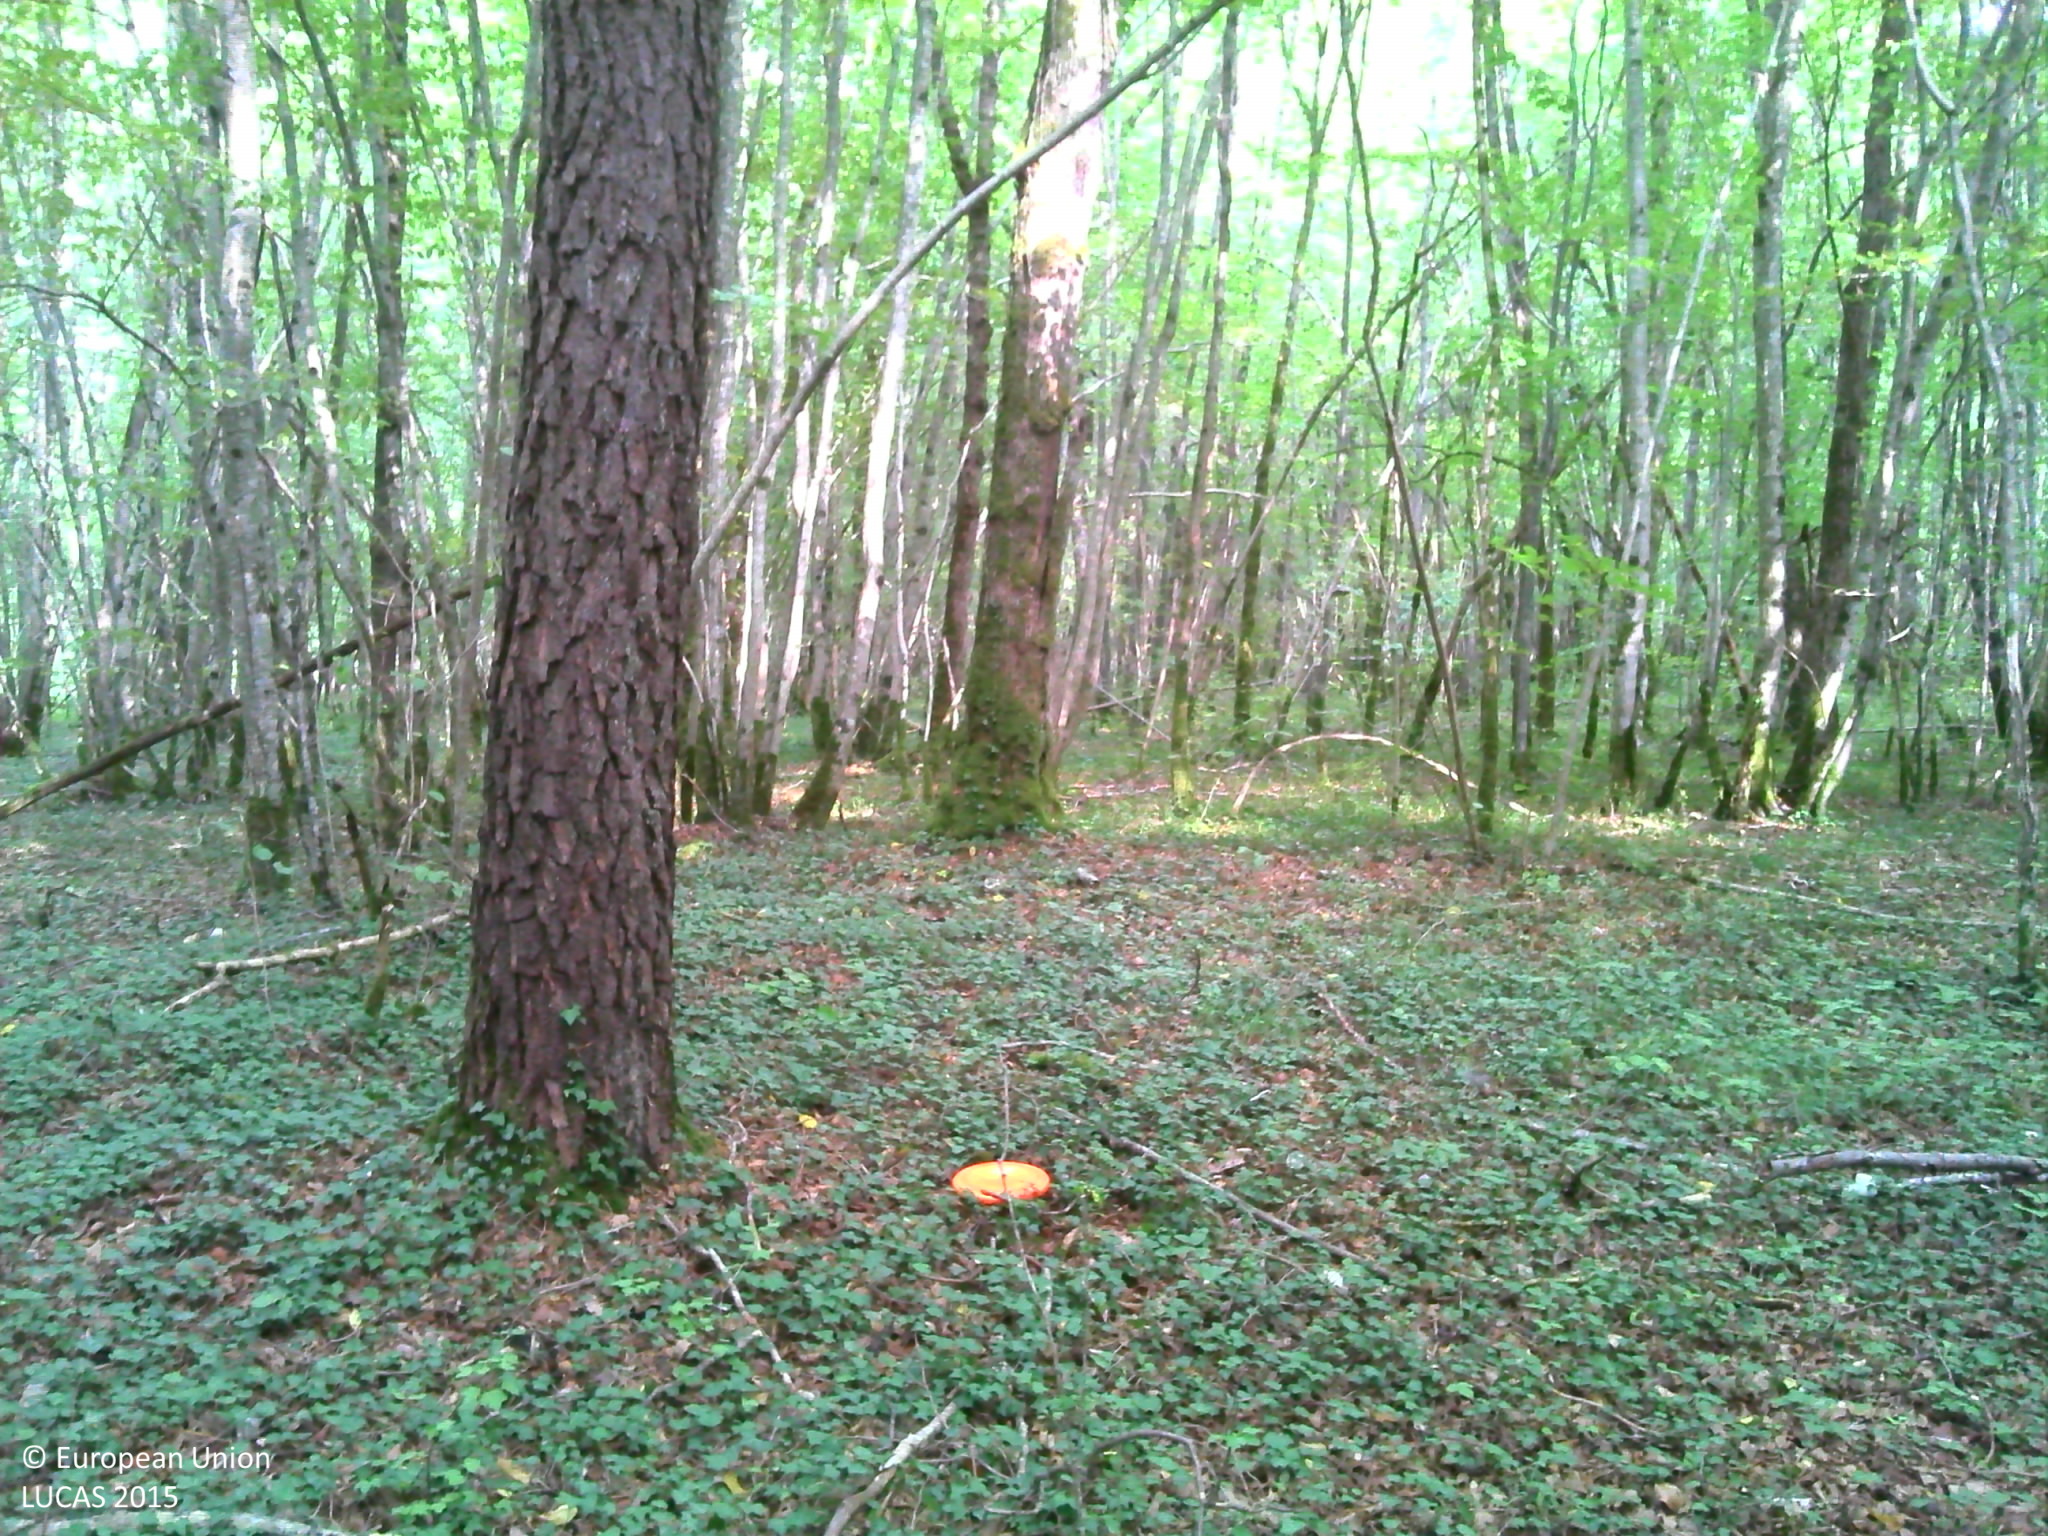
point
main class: Woodland
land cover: Broadleaved woodland
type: mesophytic deciduous forest
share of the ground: > 75 %
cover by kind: broadleaved forest trees 90 %, herbaceous plants 5 %, lichens and mosses 5 %
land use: Forestry
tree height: > 5 m
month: September
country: FR
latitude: 47.5241
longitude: 4.8067
